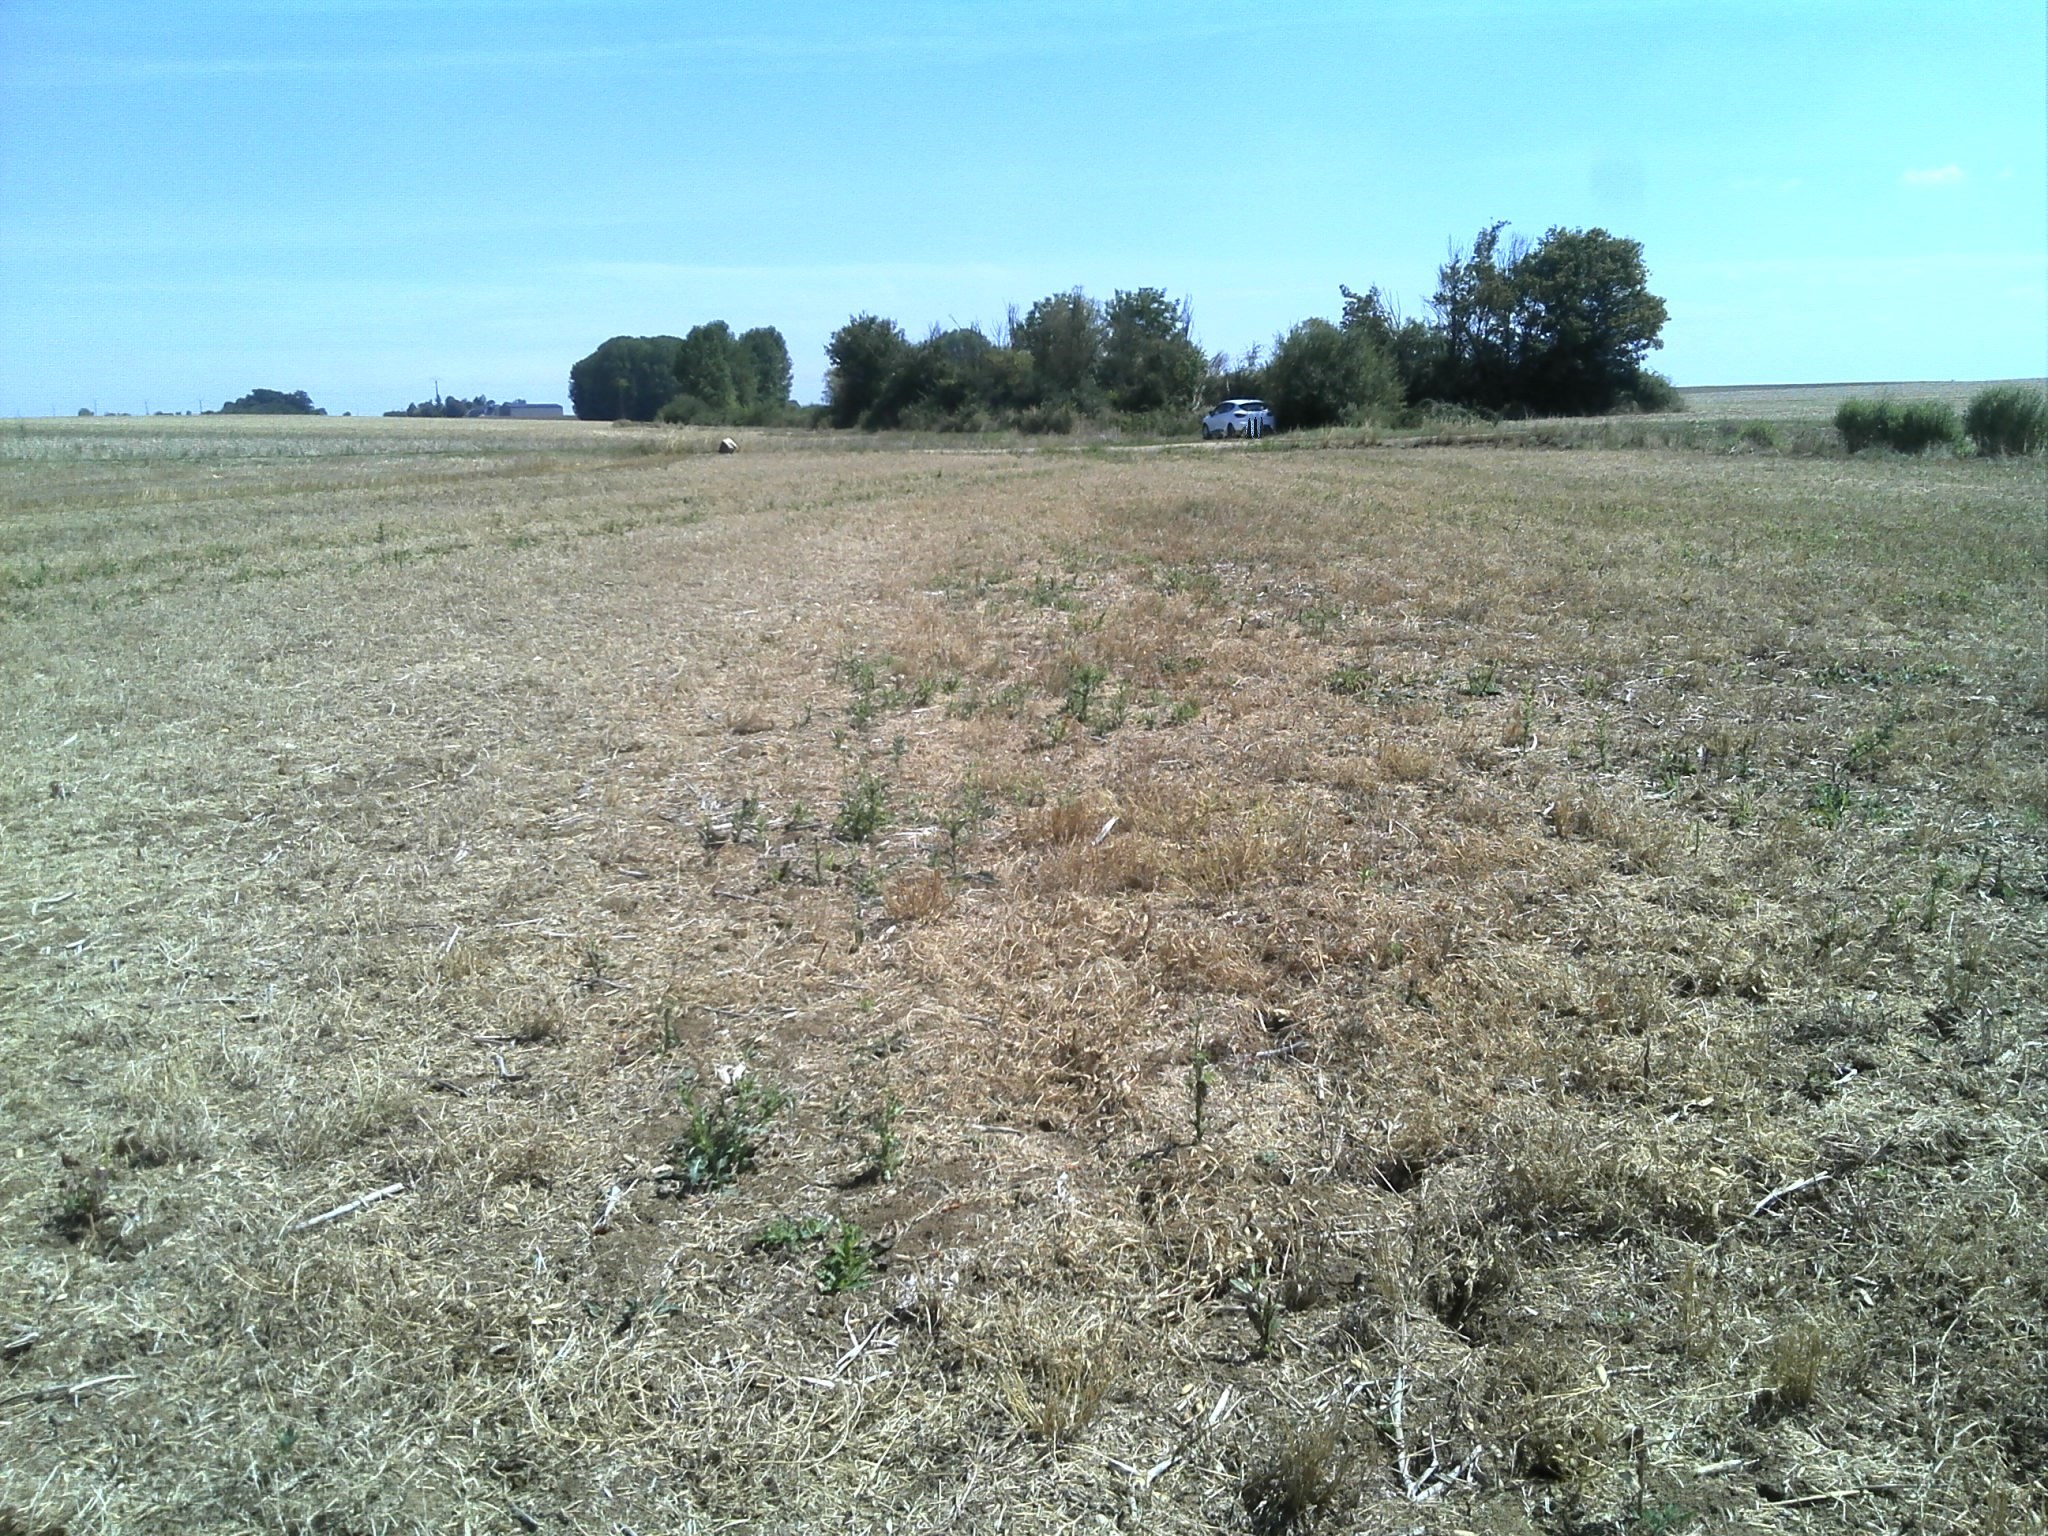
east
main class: Cropland
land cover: Dry pulses
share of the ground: 25 - 50 %
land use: Agriculture (excluding fallow land and kitchen gardens)
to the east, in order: Dry pulses; Tracks; Rape and turnip rape; Tracks; Ditches and canals; Broadleaved woodland; Common wheat
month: August
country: FR
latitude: 46.9507
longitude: 1.4605
